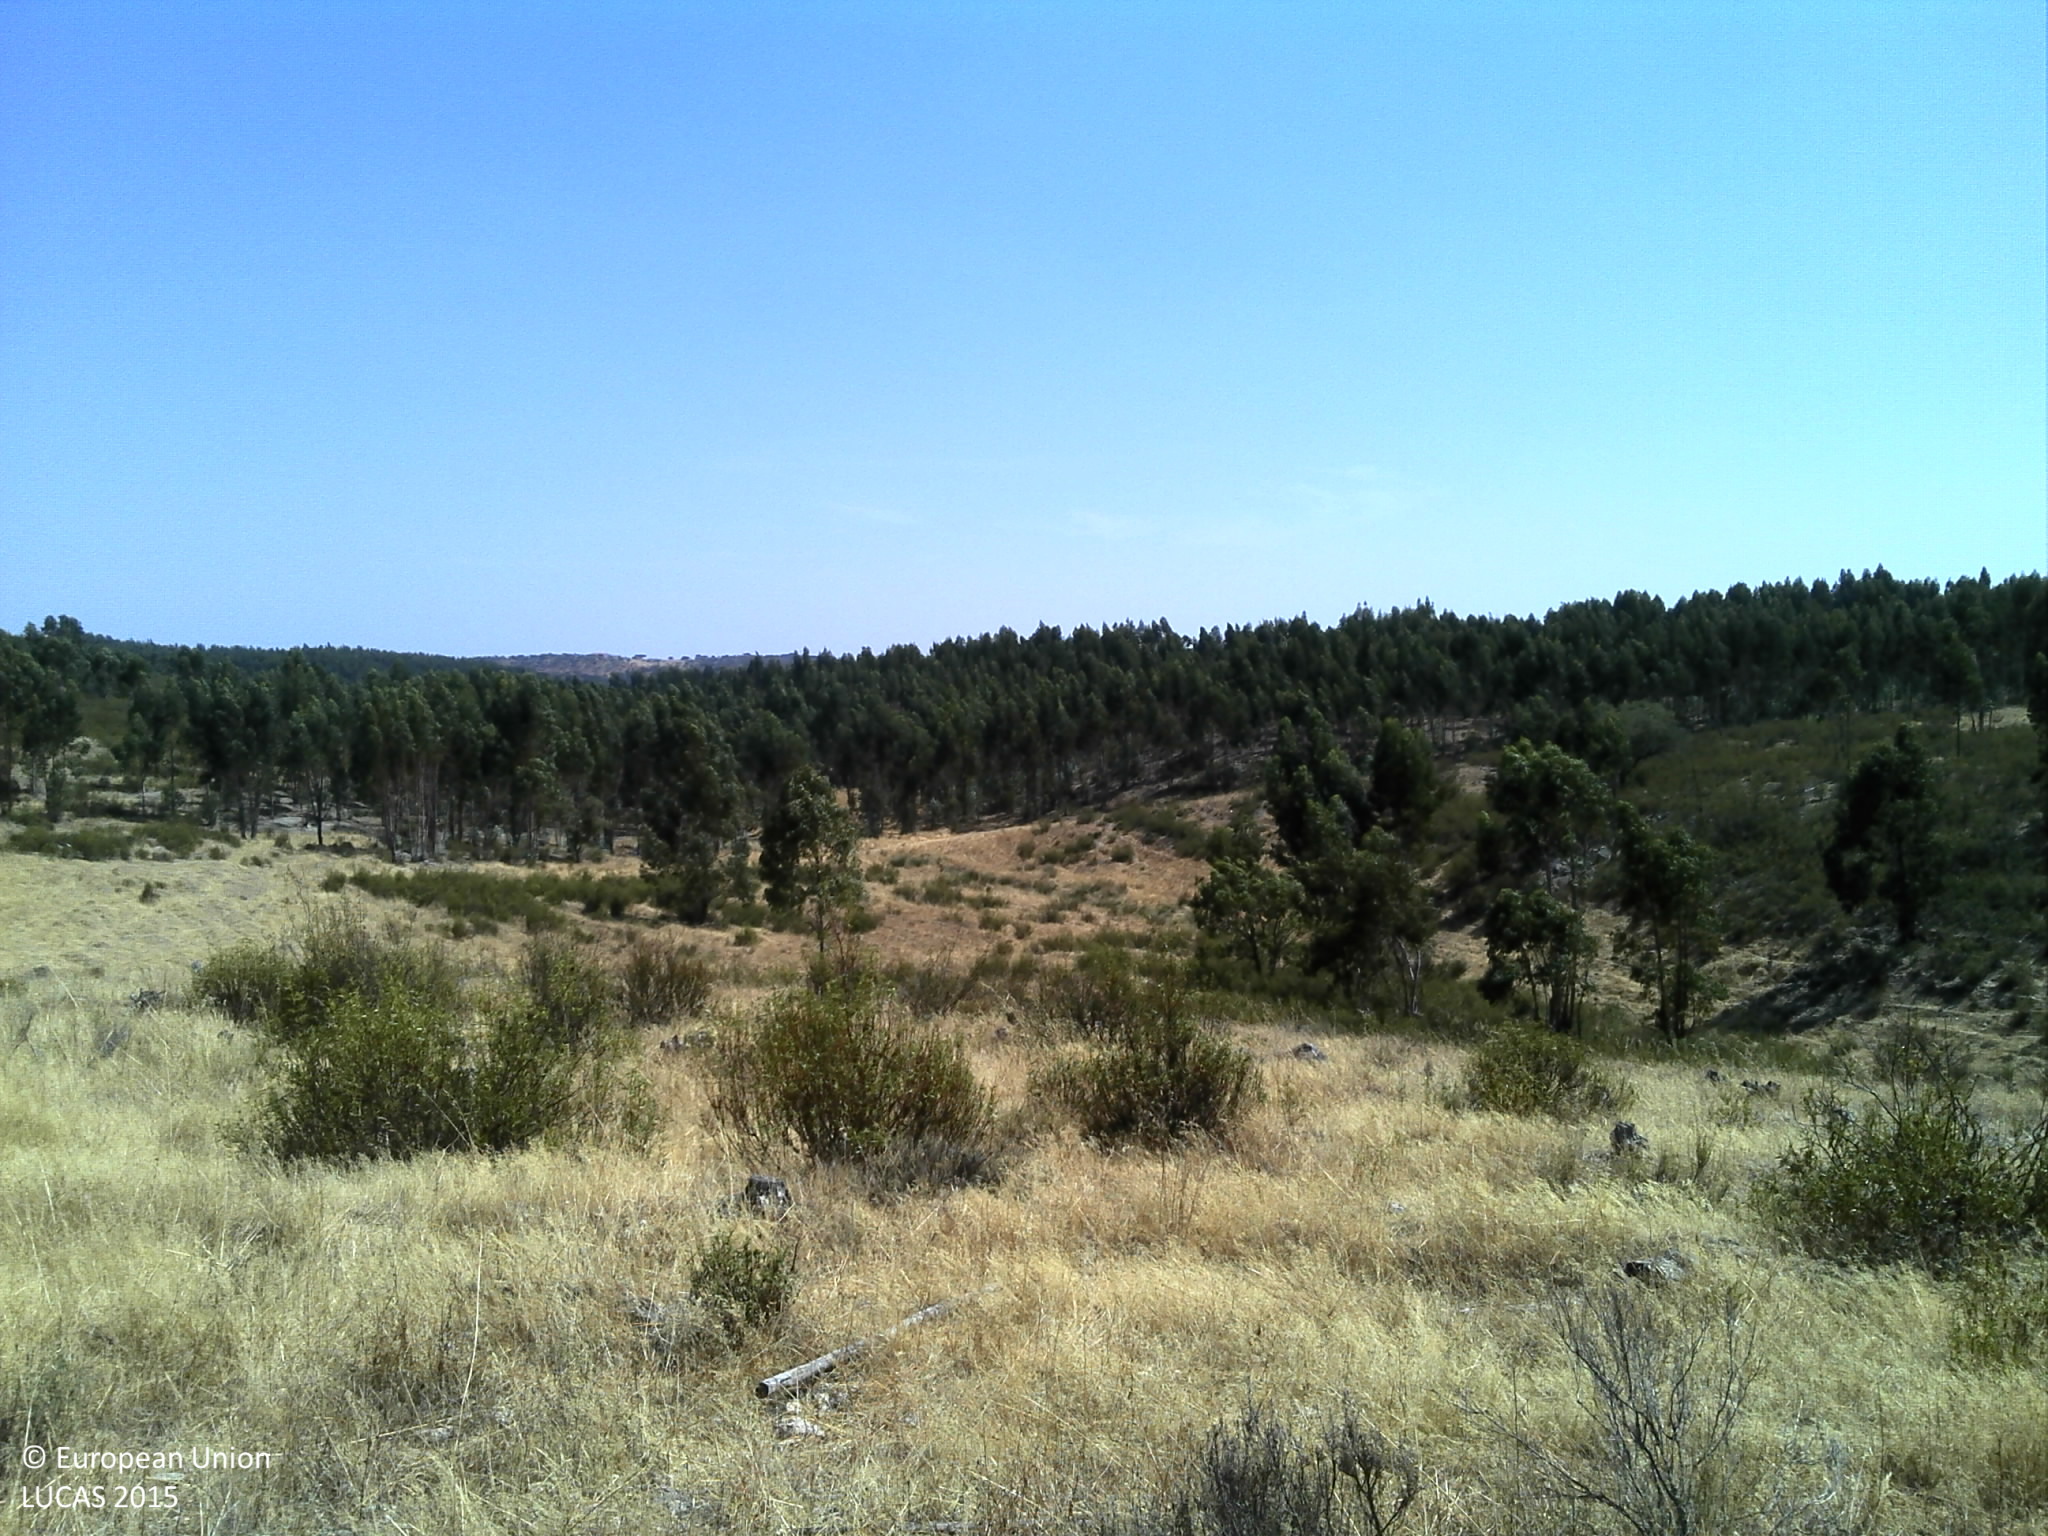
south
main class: Shrubland
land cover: Shrubland without tree cover
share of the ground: 25 - 50 %
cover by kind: herbaceous plants 60 %, shrubs 25 %, unconsolidated bare surface 15 %
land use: Agriculture (excluding fallow land and kitchen gardens)
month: July
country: PT
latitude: 38.6642
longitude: -7.4885
